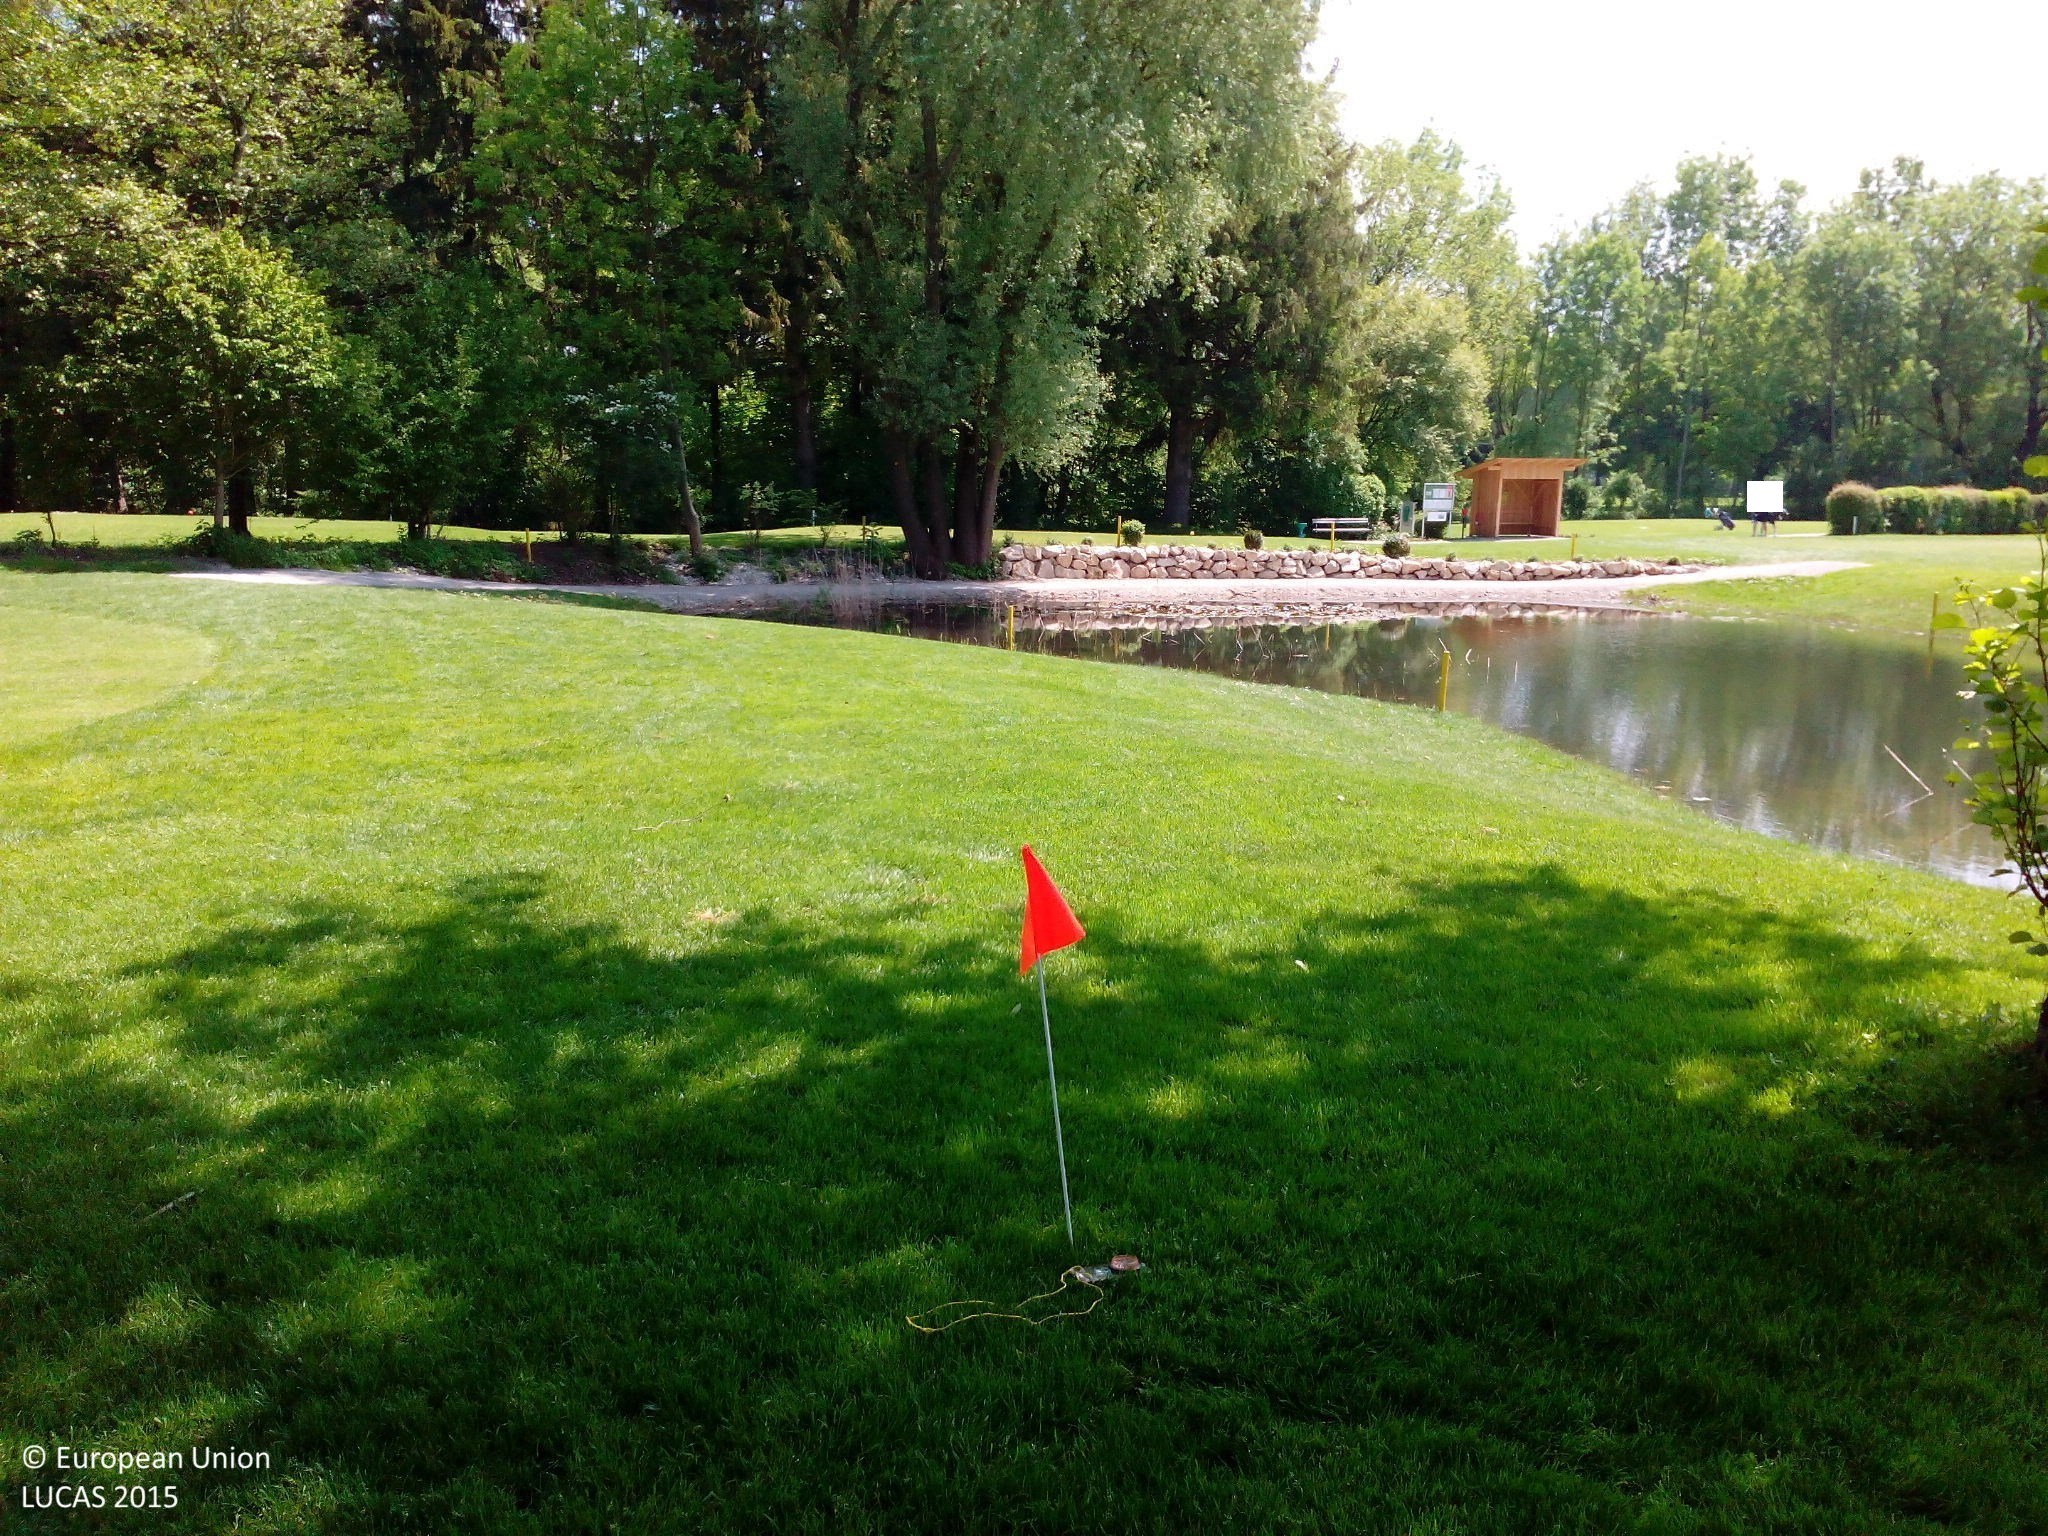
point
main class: Woodland
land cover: Broadleaved woodland
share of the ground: > 75 %
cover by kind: broadleaved forest trees 90 %, herbaceous plants 10 %
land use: Sport
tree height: > 5 m
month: May
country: DE
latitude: 48.2145
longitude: 11.4123
